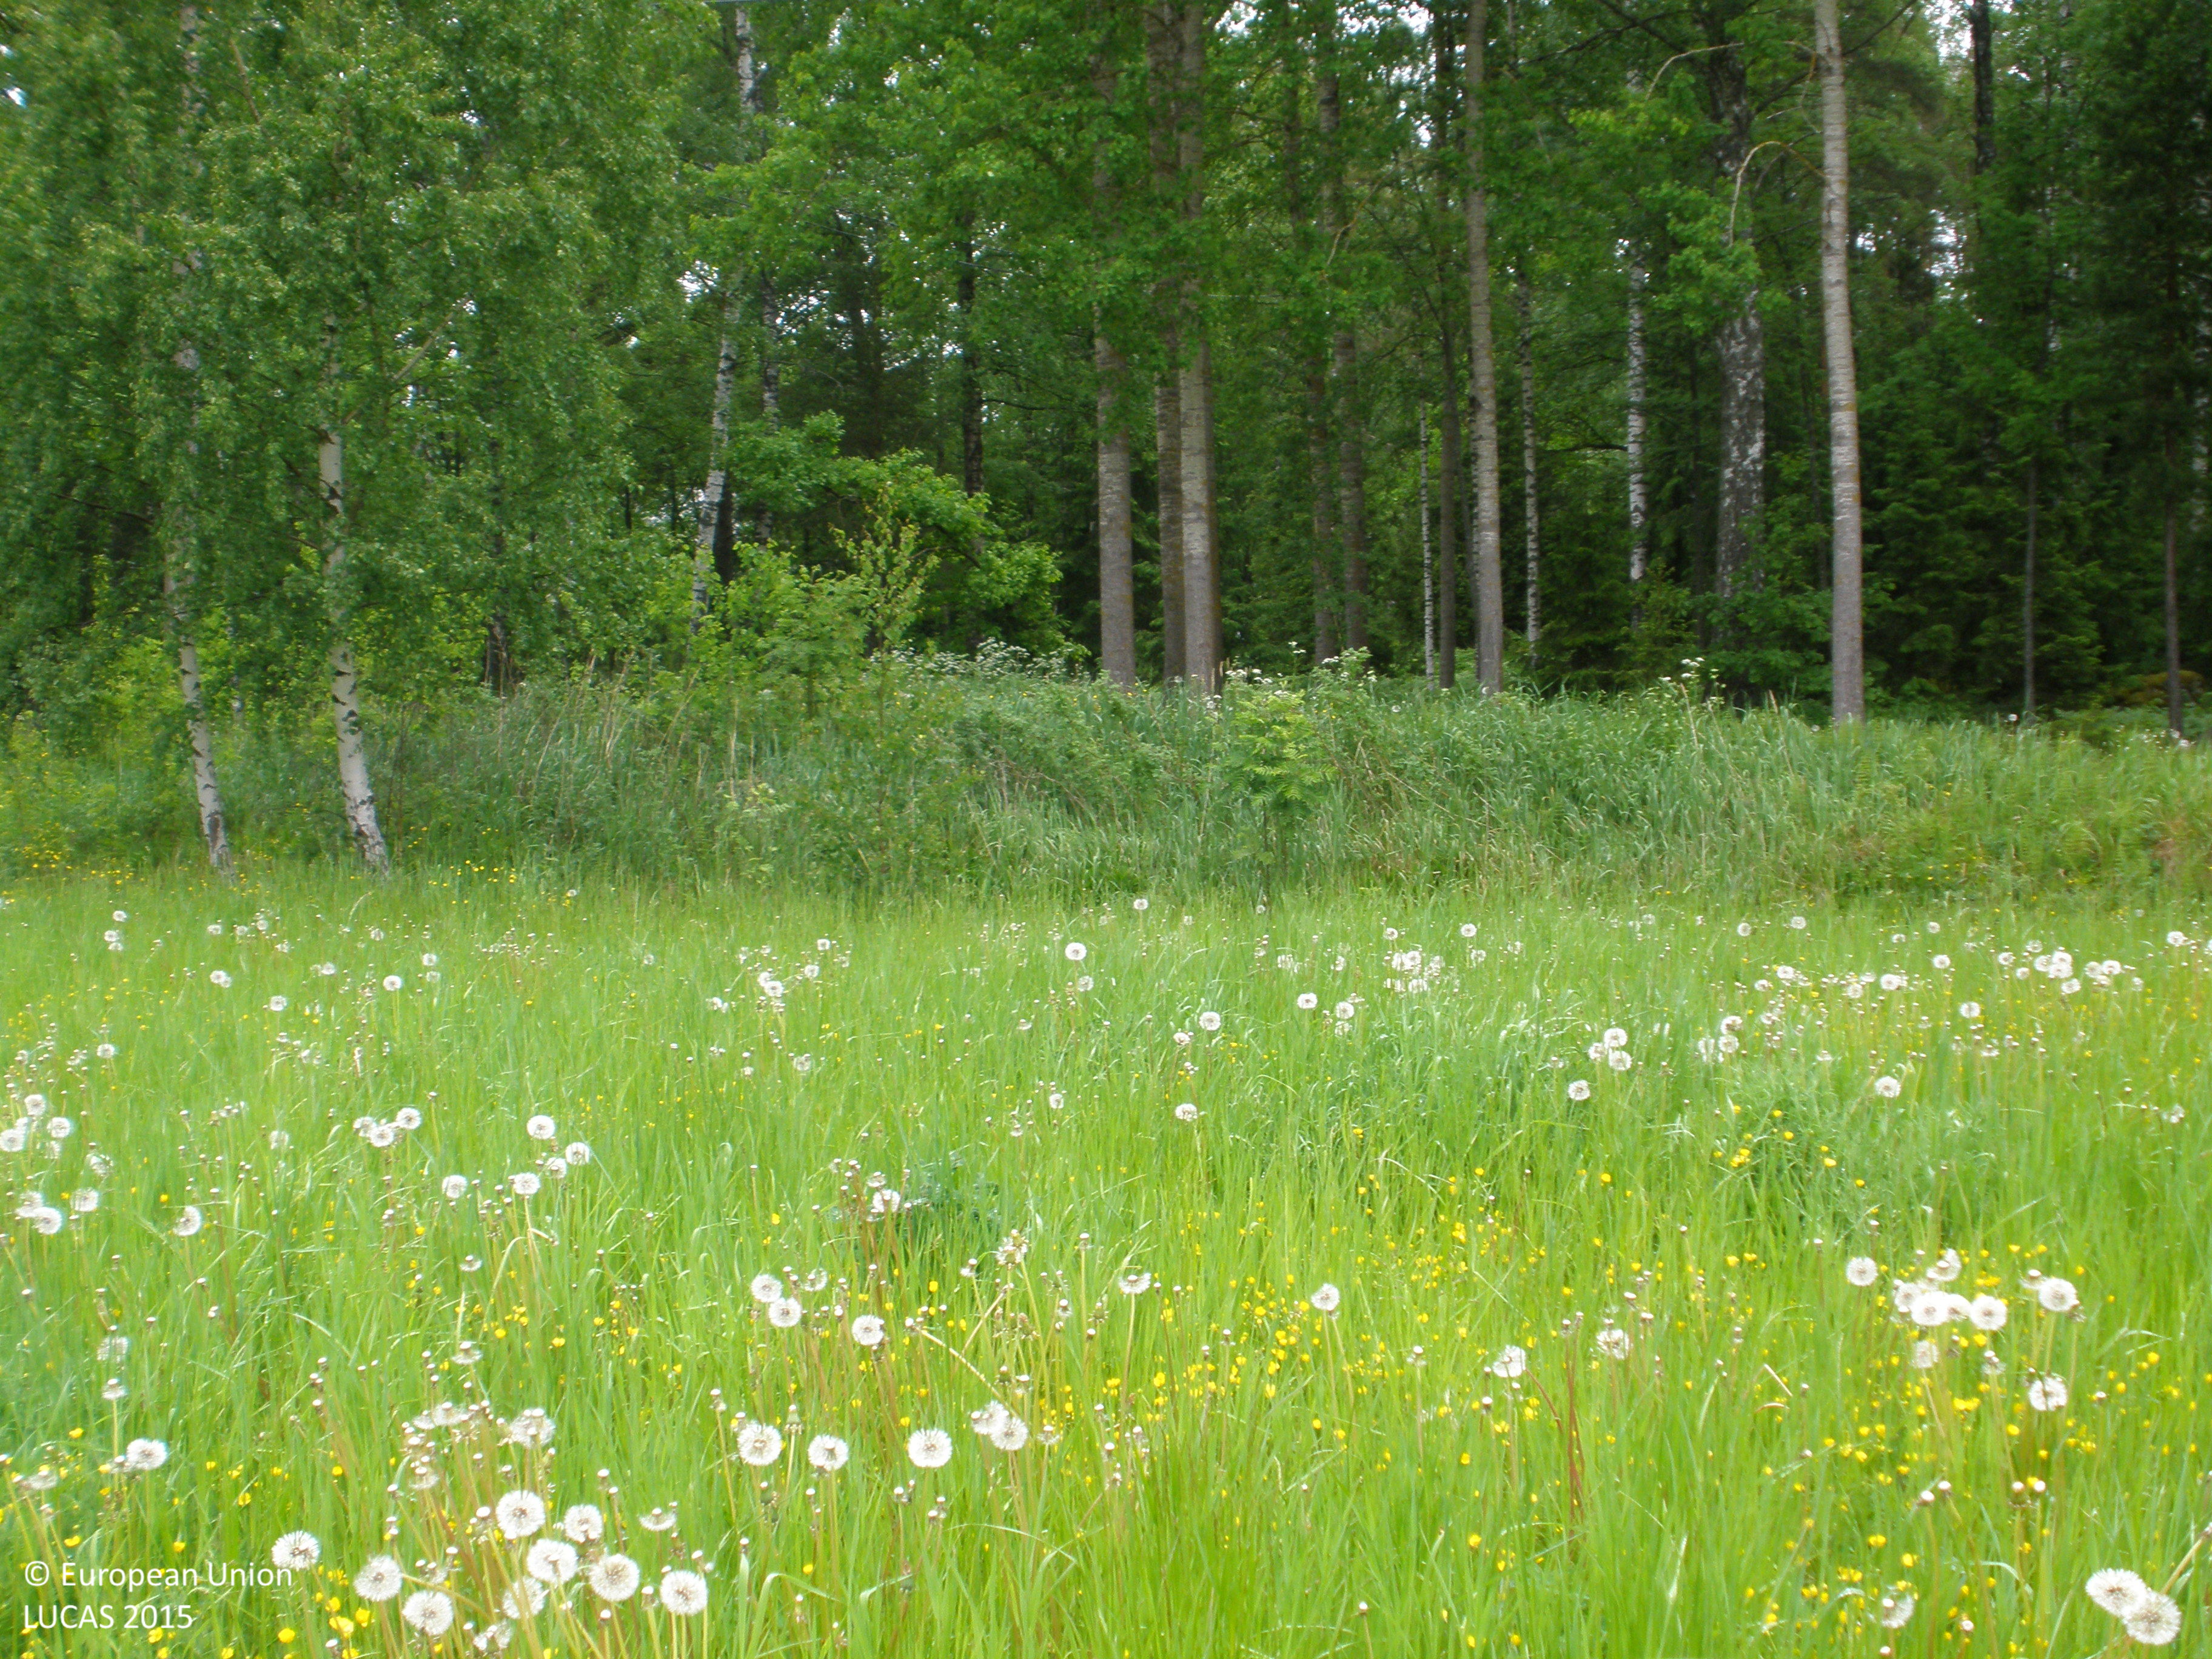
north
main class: Grassland
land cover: Grassland without tree/shrub cover
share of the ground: > 75 %
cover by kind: herbaceous plants 100 %
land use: Agriculture (excluding fallow land and kitchen gardens)
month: June
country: FI
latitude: 61.1309
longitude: 24.3393
